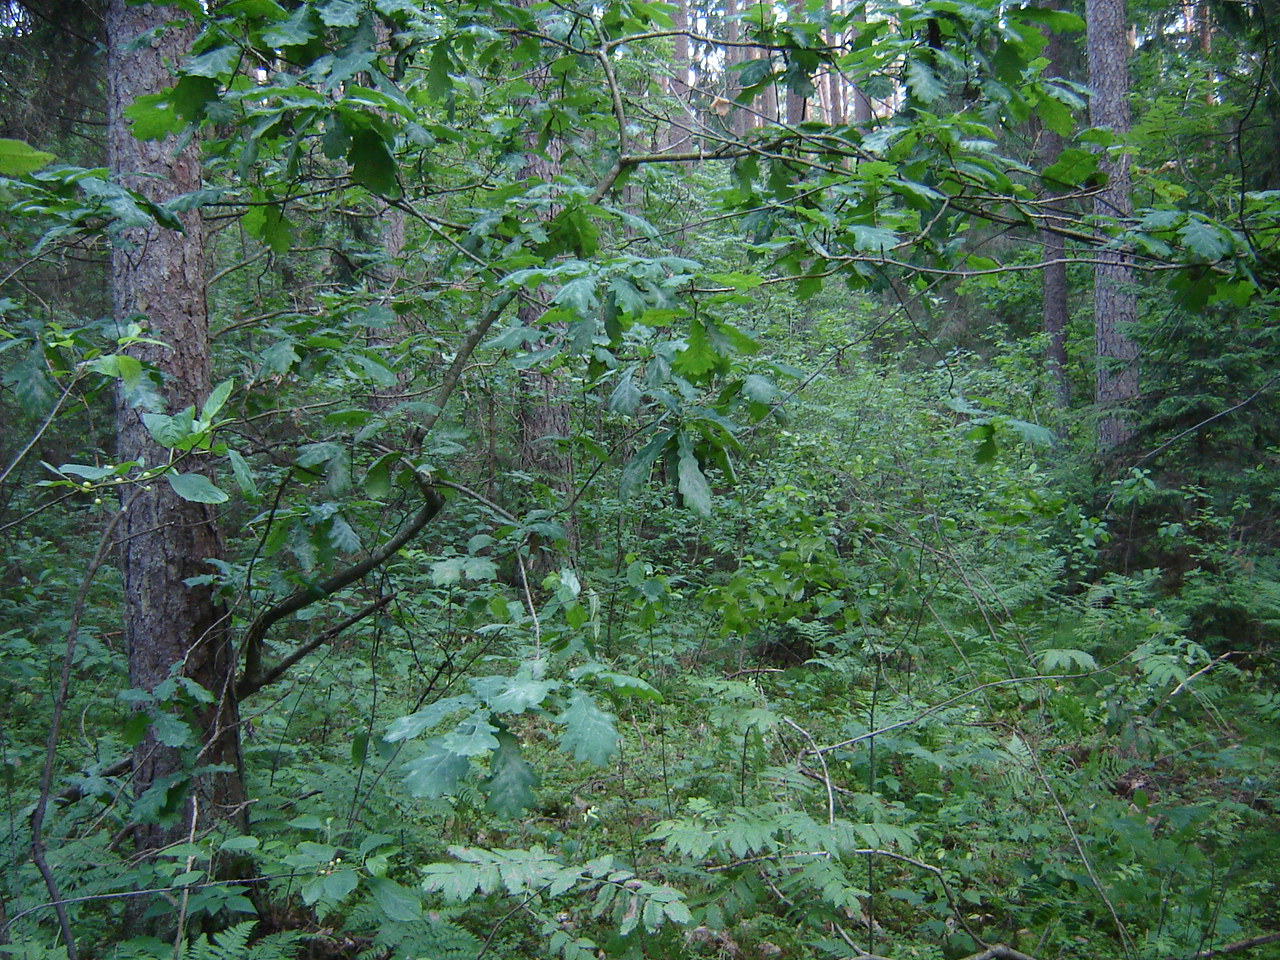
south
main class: Woodland
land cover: Pine dominated coniferous woodland
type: hemiboreal forest and nemoral coniferous forest and mixed broadleaved-coniferous forest
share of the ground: > 75 %
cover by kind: coniferous forest trees 80 %, broadleaved forest trees 10 %, herbaceous plants 5 %, lichens and mosses 5 %
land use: Forestry
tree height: > 5 m
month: July
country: LT
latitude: 55.5093
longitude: 25.0772
